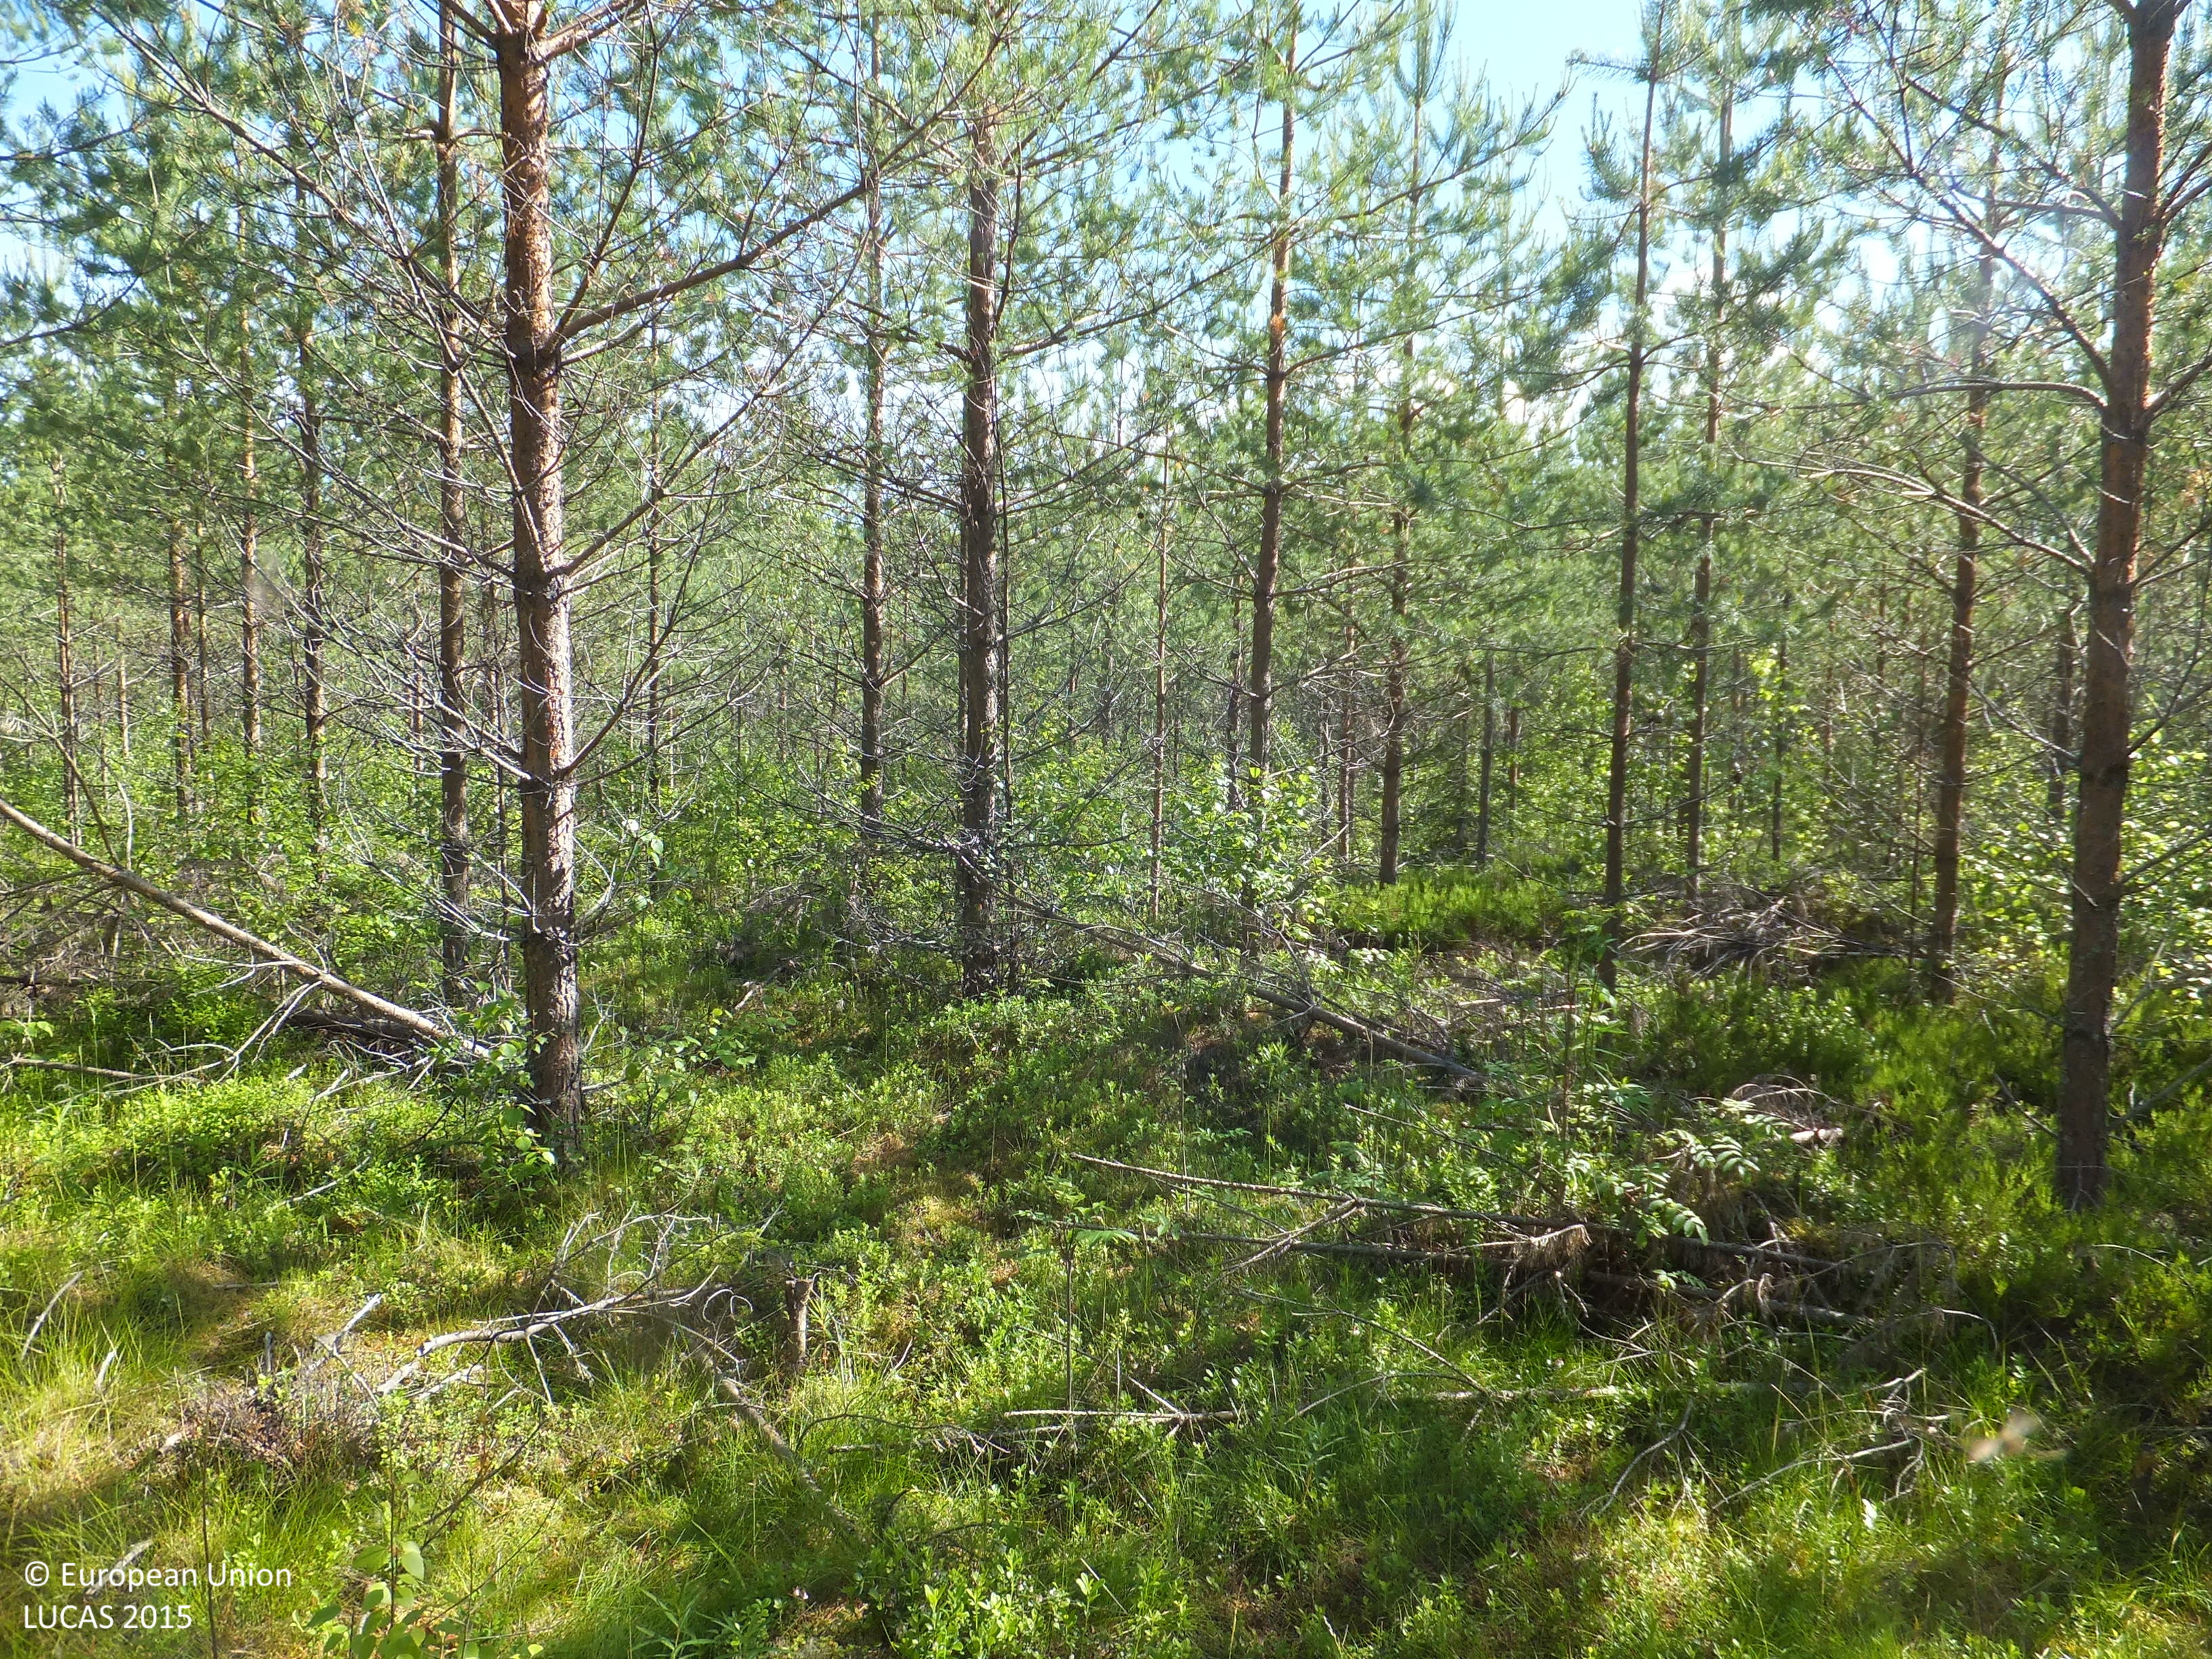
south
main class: Woodland
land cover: Pine dominated coniferous woodland
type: boreal forest
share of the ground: > 75 %
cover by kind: coniferous forest trees 80 %, shrubs 10 %, broadleaved forest trees 5 %, herbaceous plants 5 %
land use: Forestry
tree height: < 5 m
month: July
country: FI
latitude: 63.0862
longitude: 23.8743
